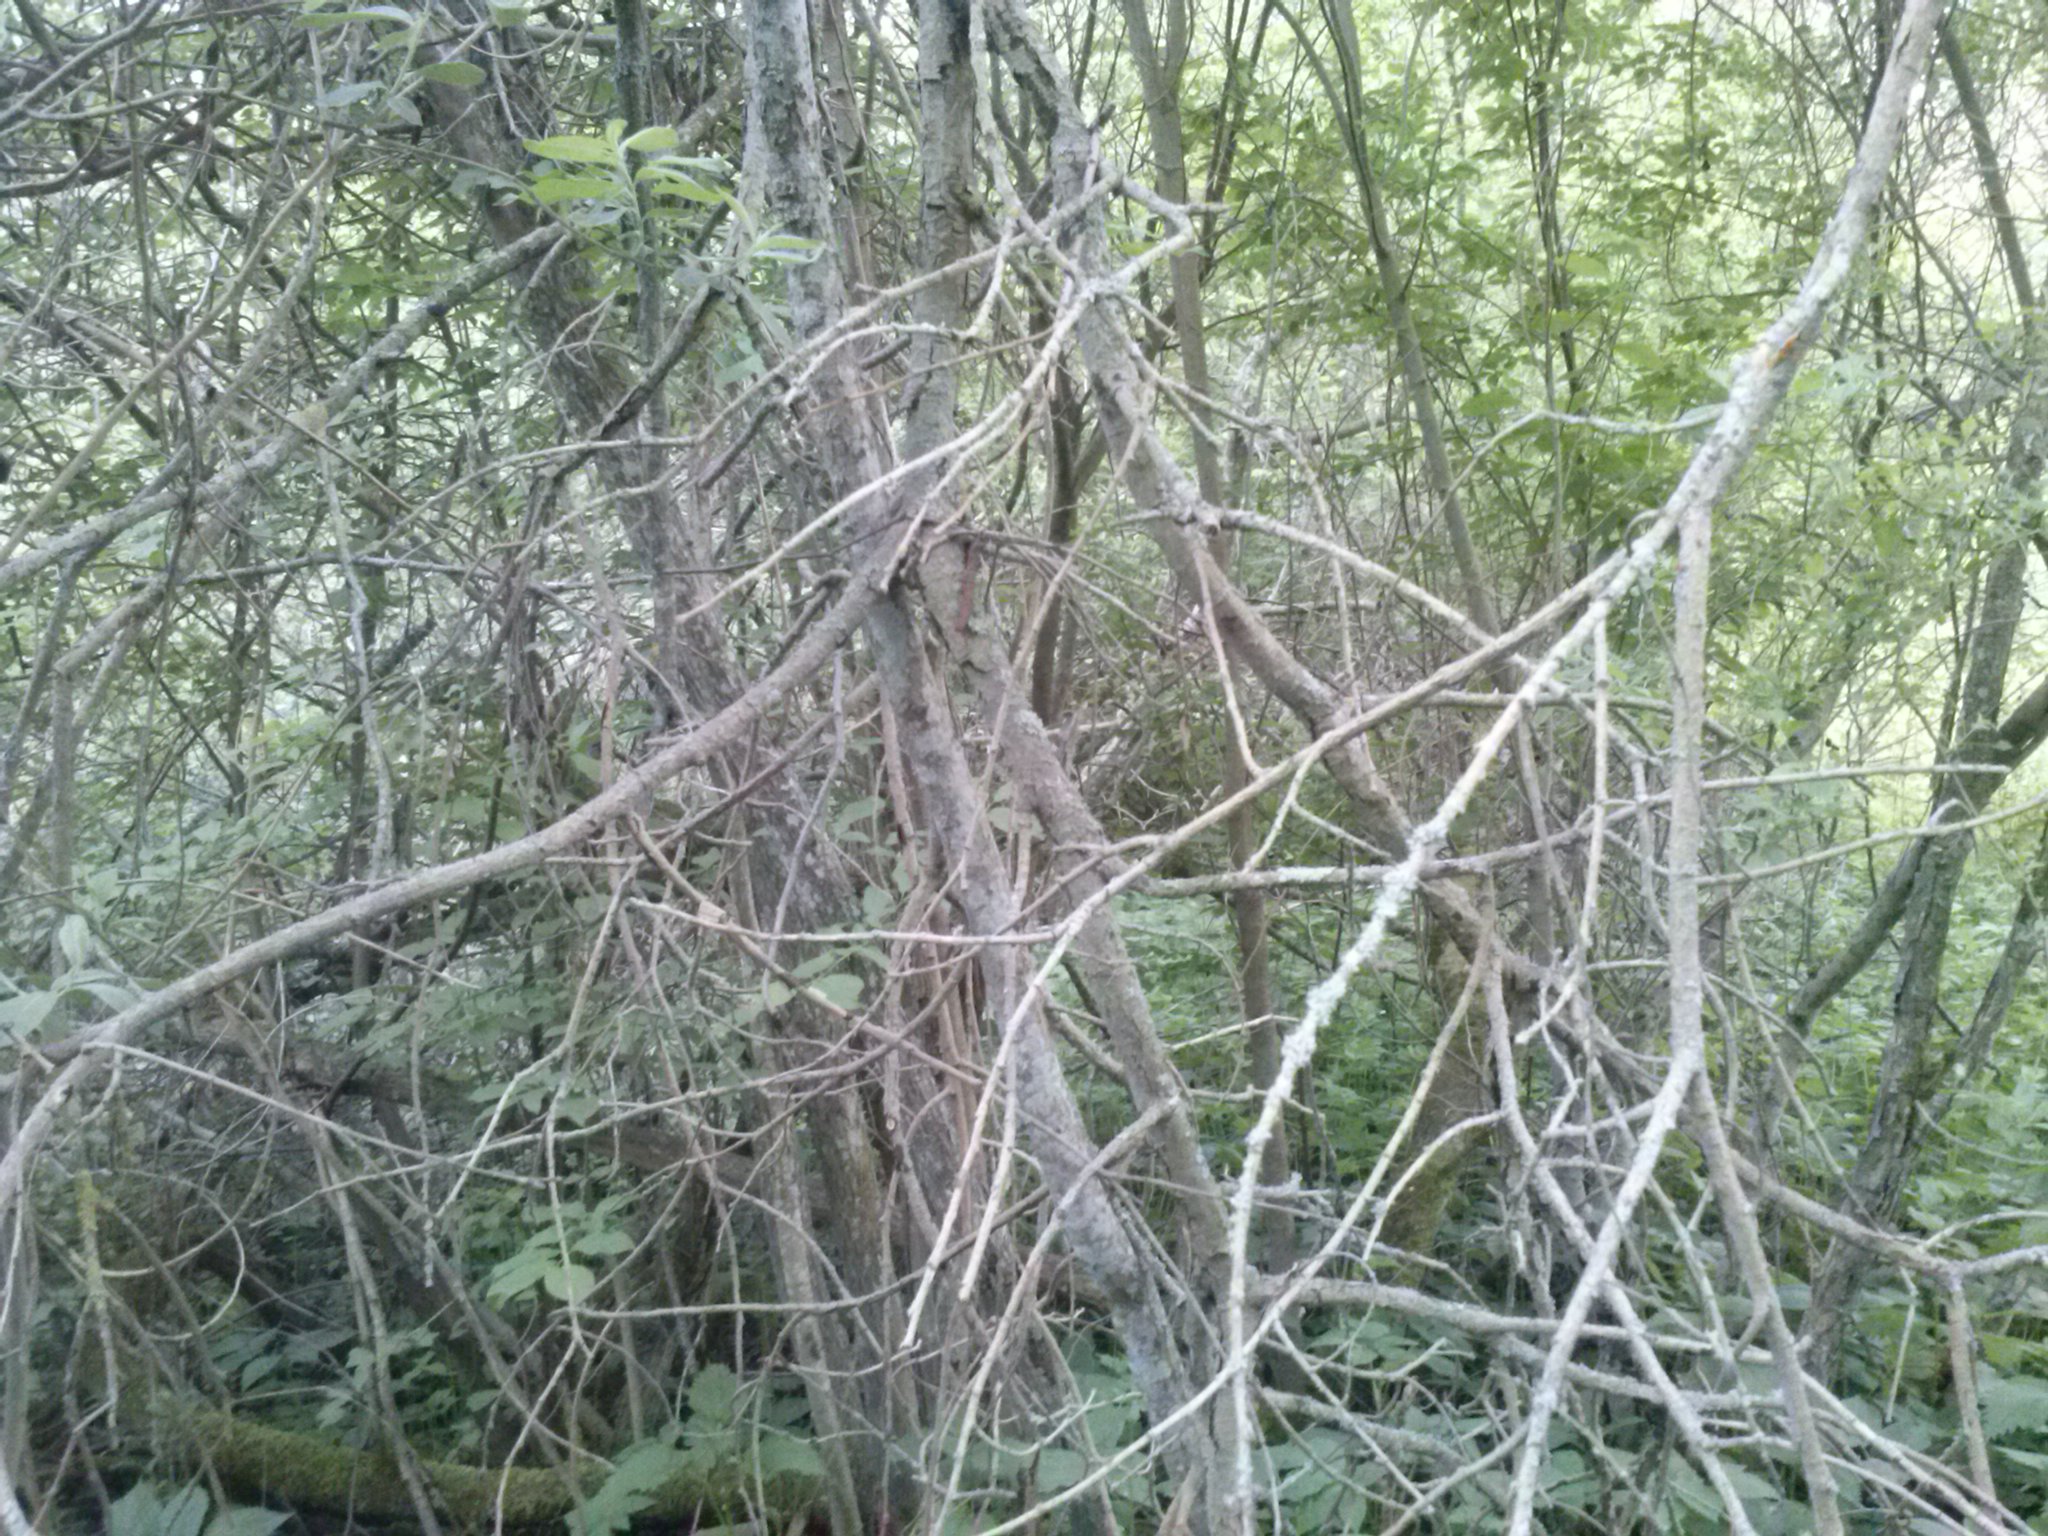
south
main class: Grassland
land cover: Grassland with sparse tree/shrub cover
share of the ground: > 75 %
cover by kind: herbaceous plants 90 %, broadleaved forest trees 5 %, shrubs 5 %
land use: Semi-natural and natural areas not in use
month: May
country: LV
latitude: 56.3048
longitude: 27.8578
